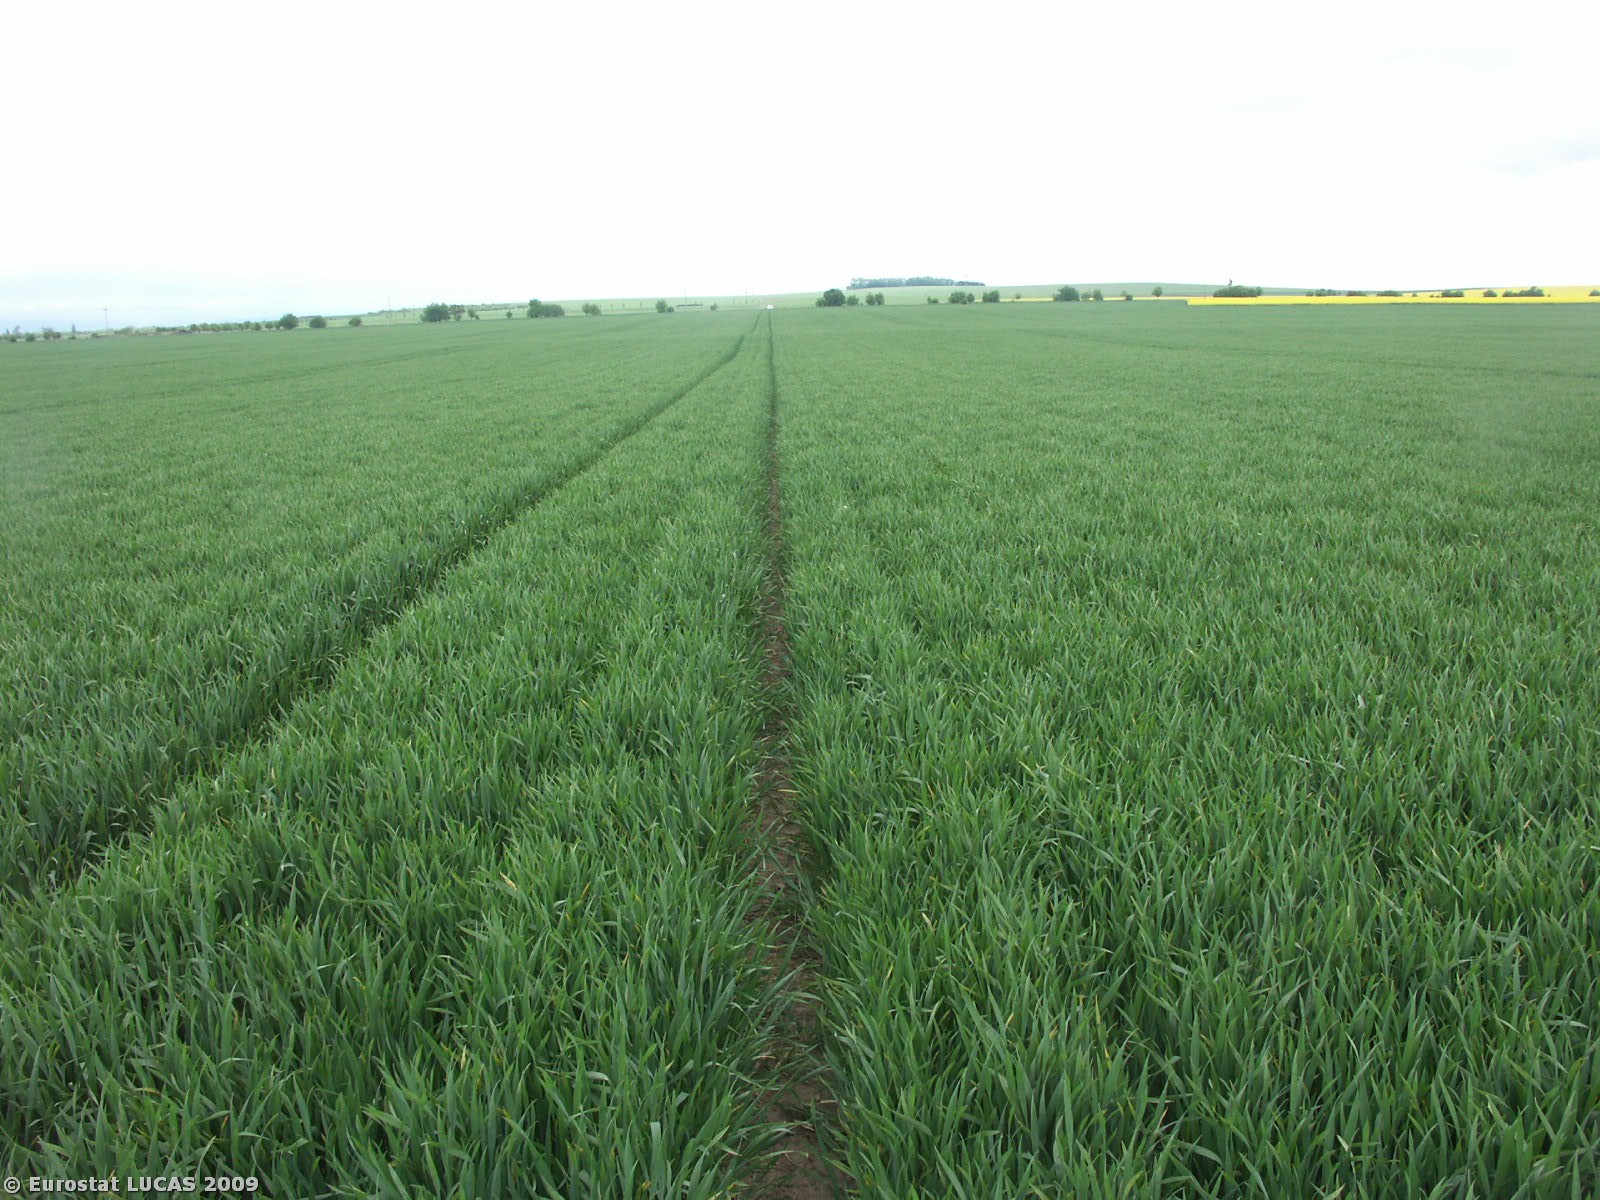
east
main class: Cropland
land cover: Common wheat
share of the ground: > 75 %
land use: Agriculture (excluding fallow land and kitchen gardens)
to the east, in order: Common wheat
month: May
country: CZ
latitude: 49.6174
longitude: 17.1384
